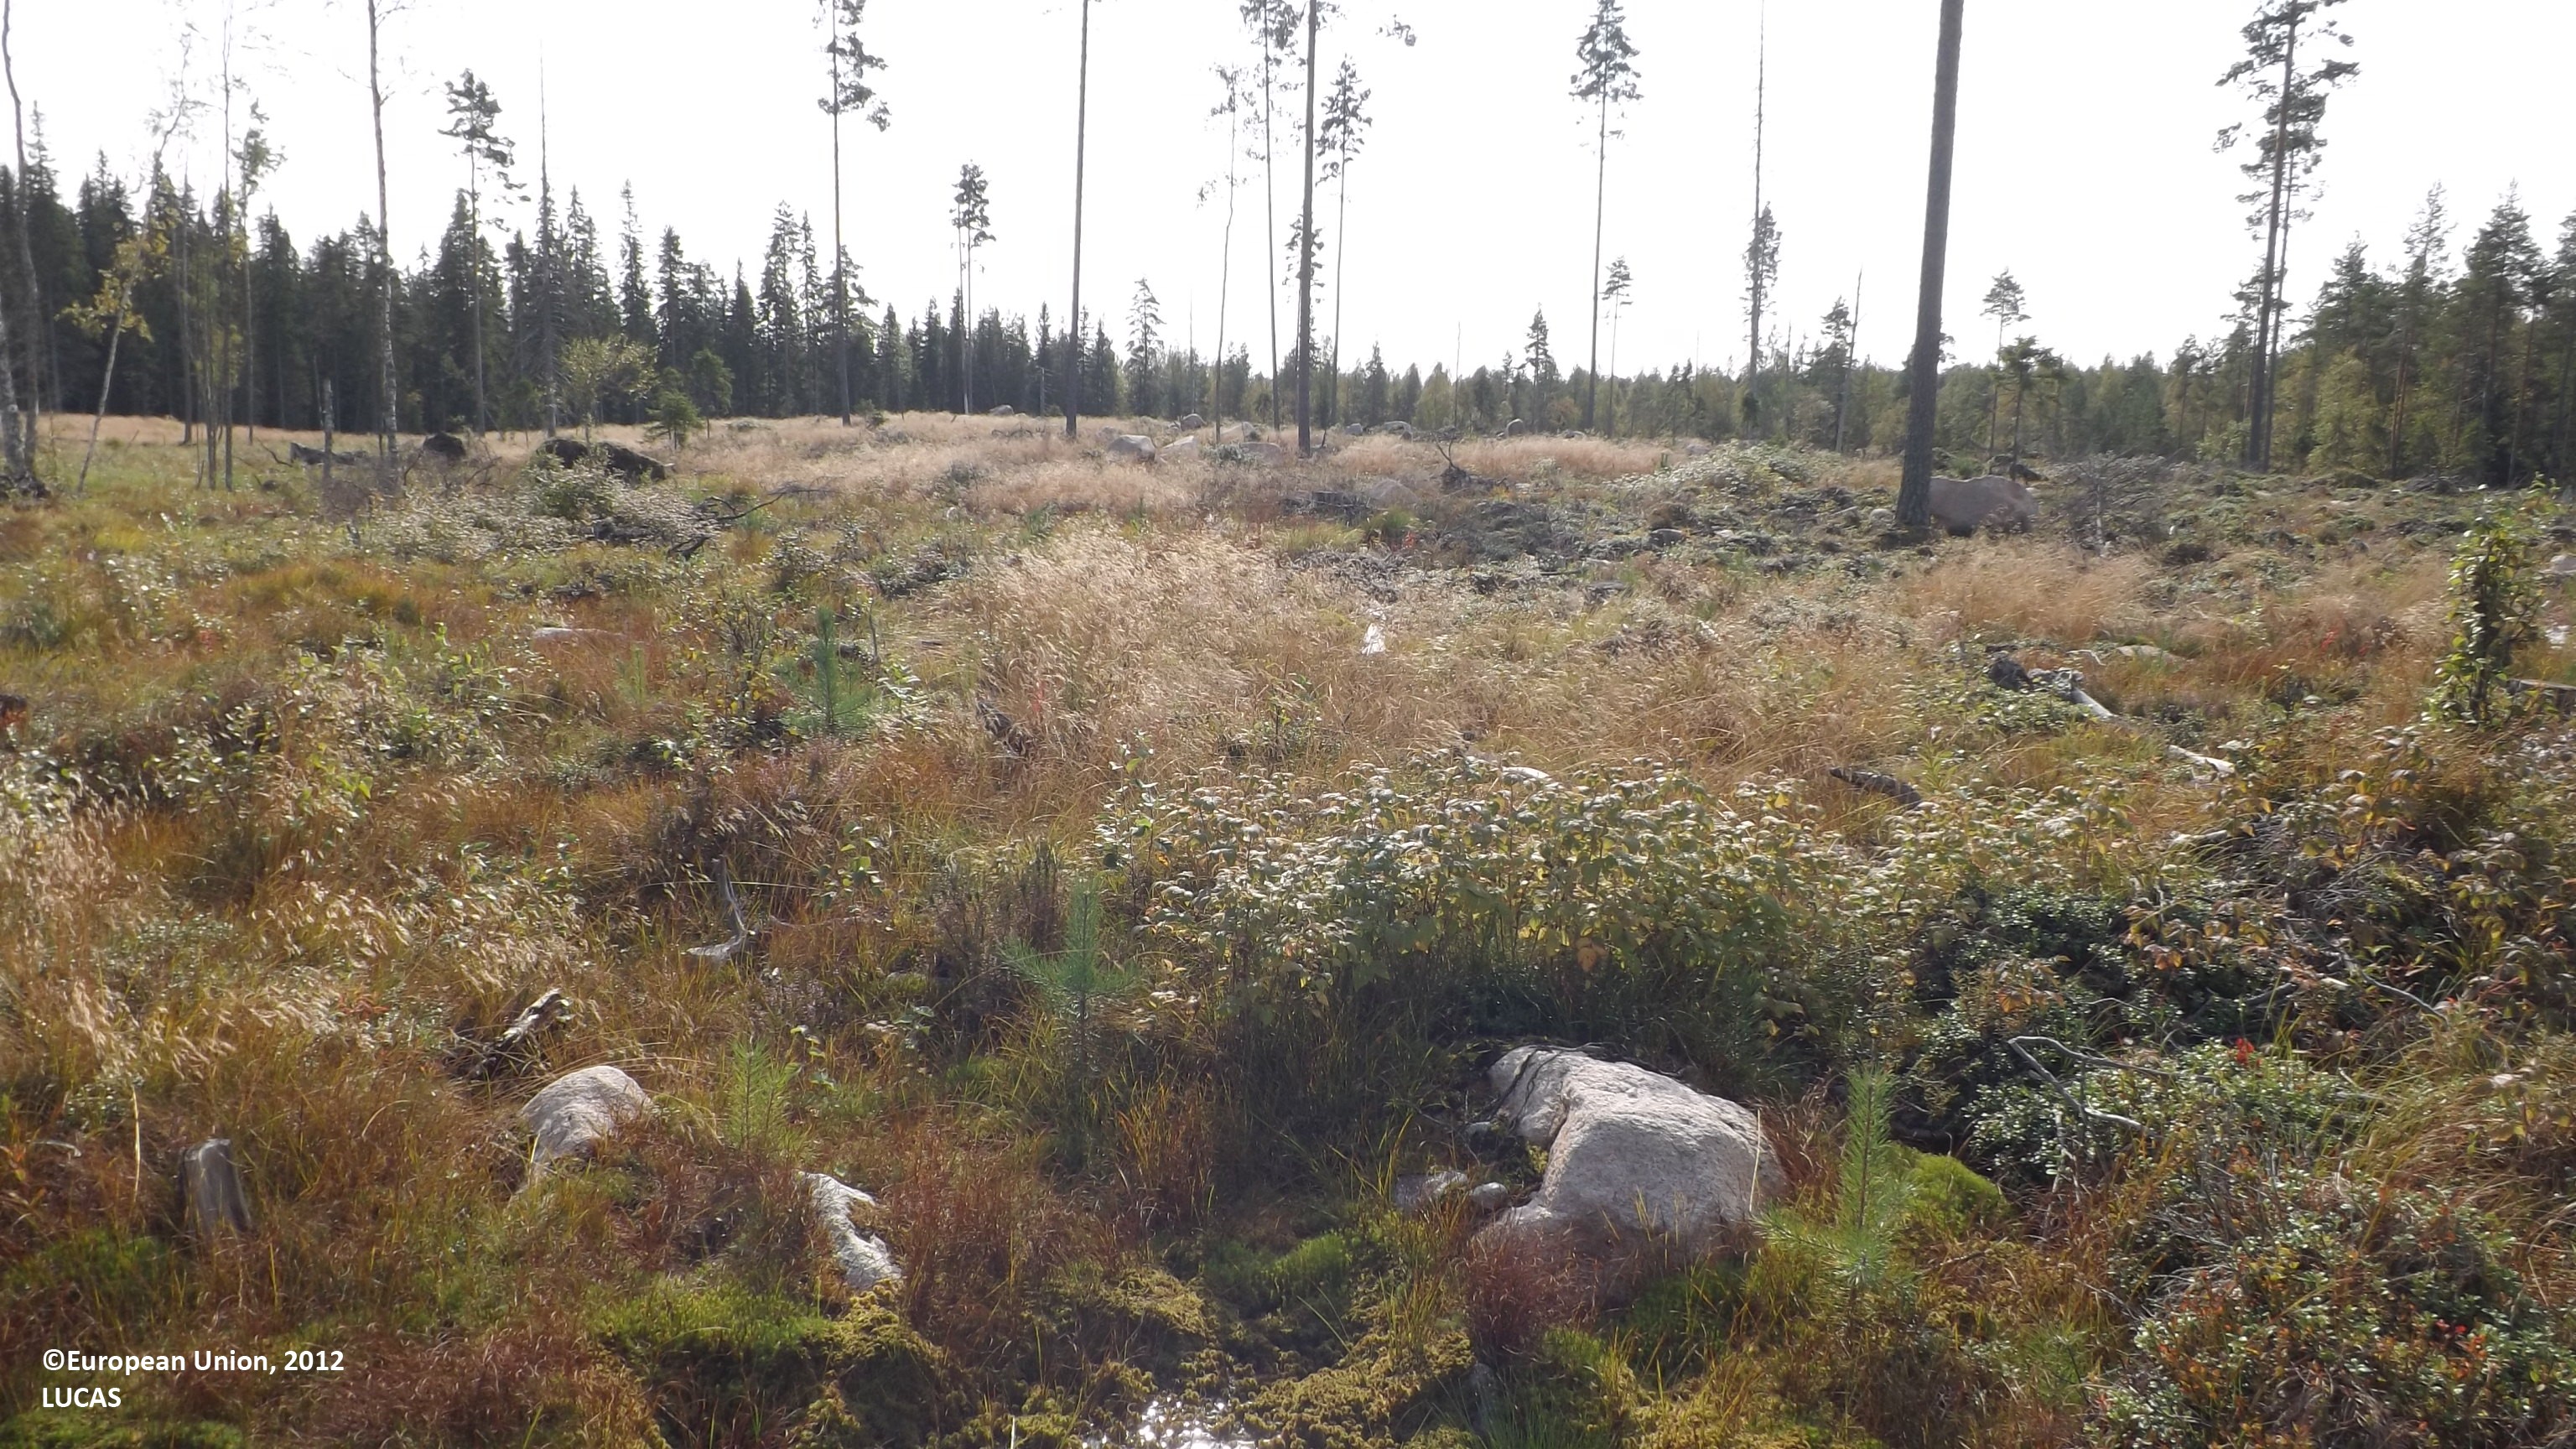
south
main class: Grassland
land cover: Grassland with sparse tree/shrub cover
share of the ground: 25 - 50 %
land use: Forestry
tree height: < 5 m
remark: Clear cut
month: August
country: FI
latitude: 63.7559
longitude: 23.5803
